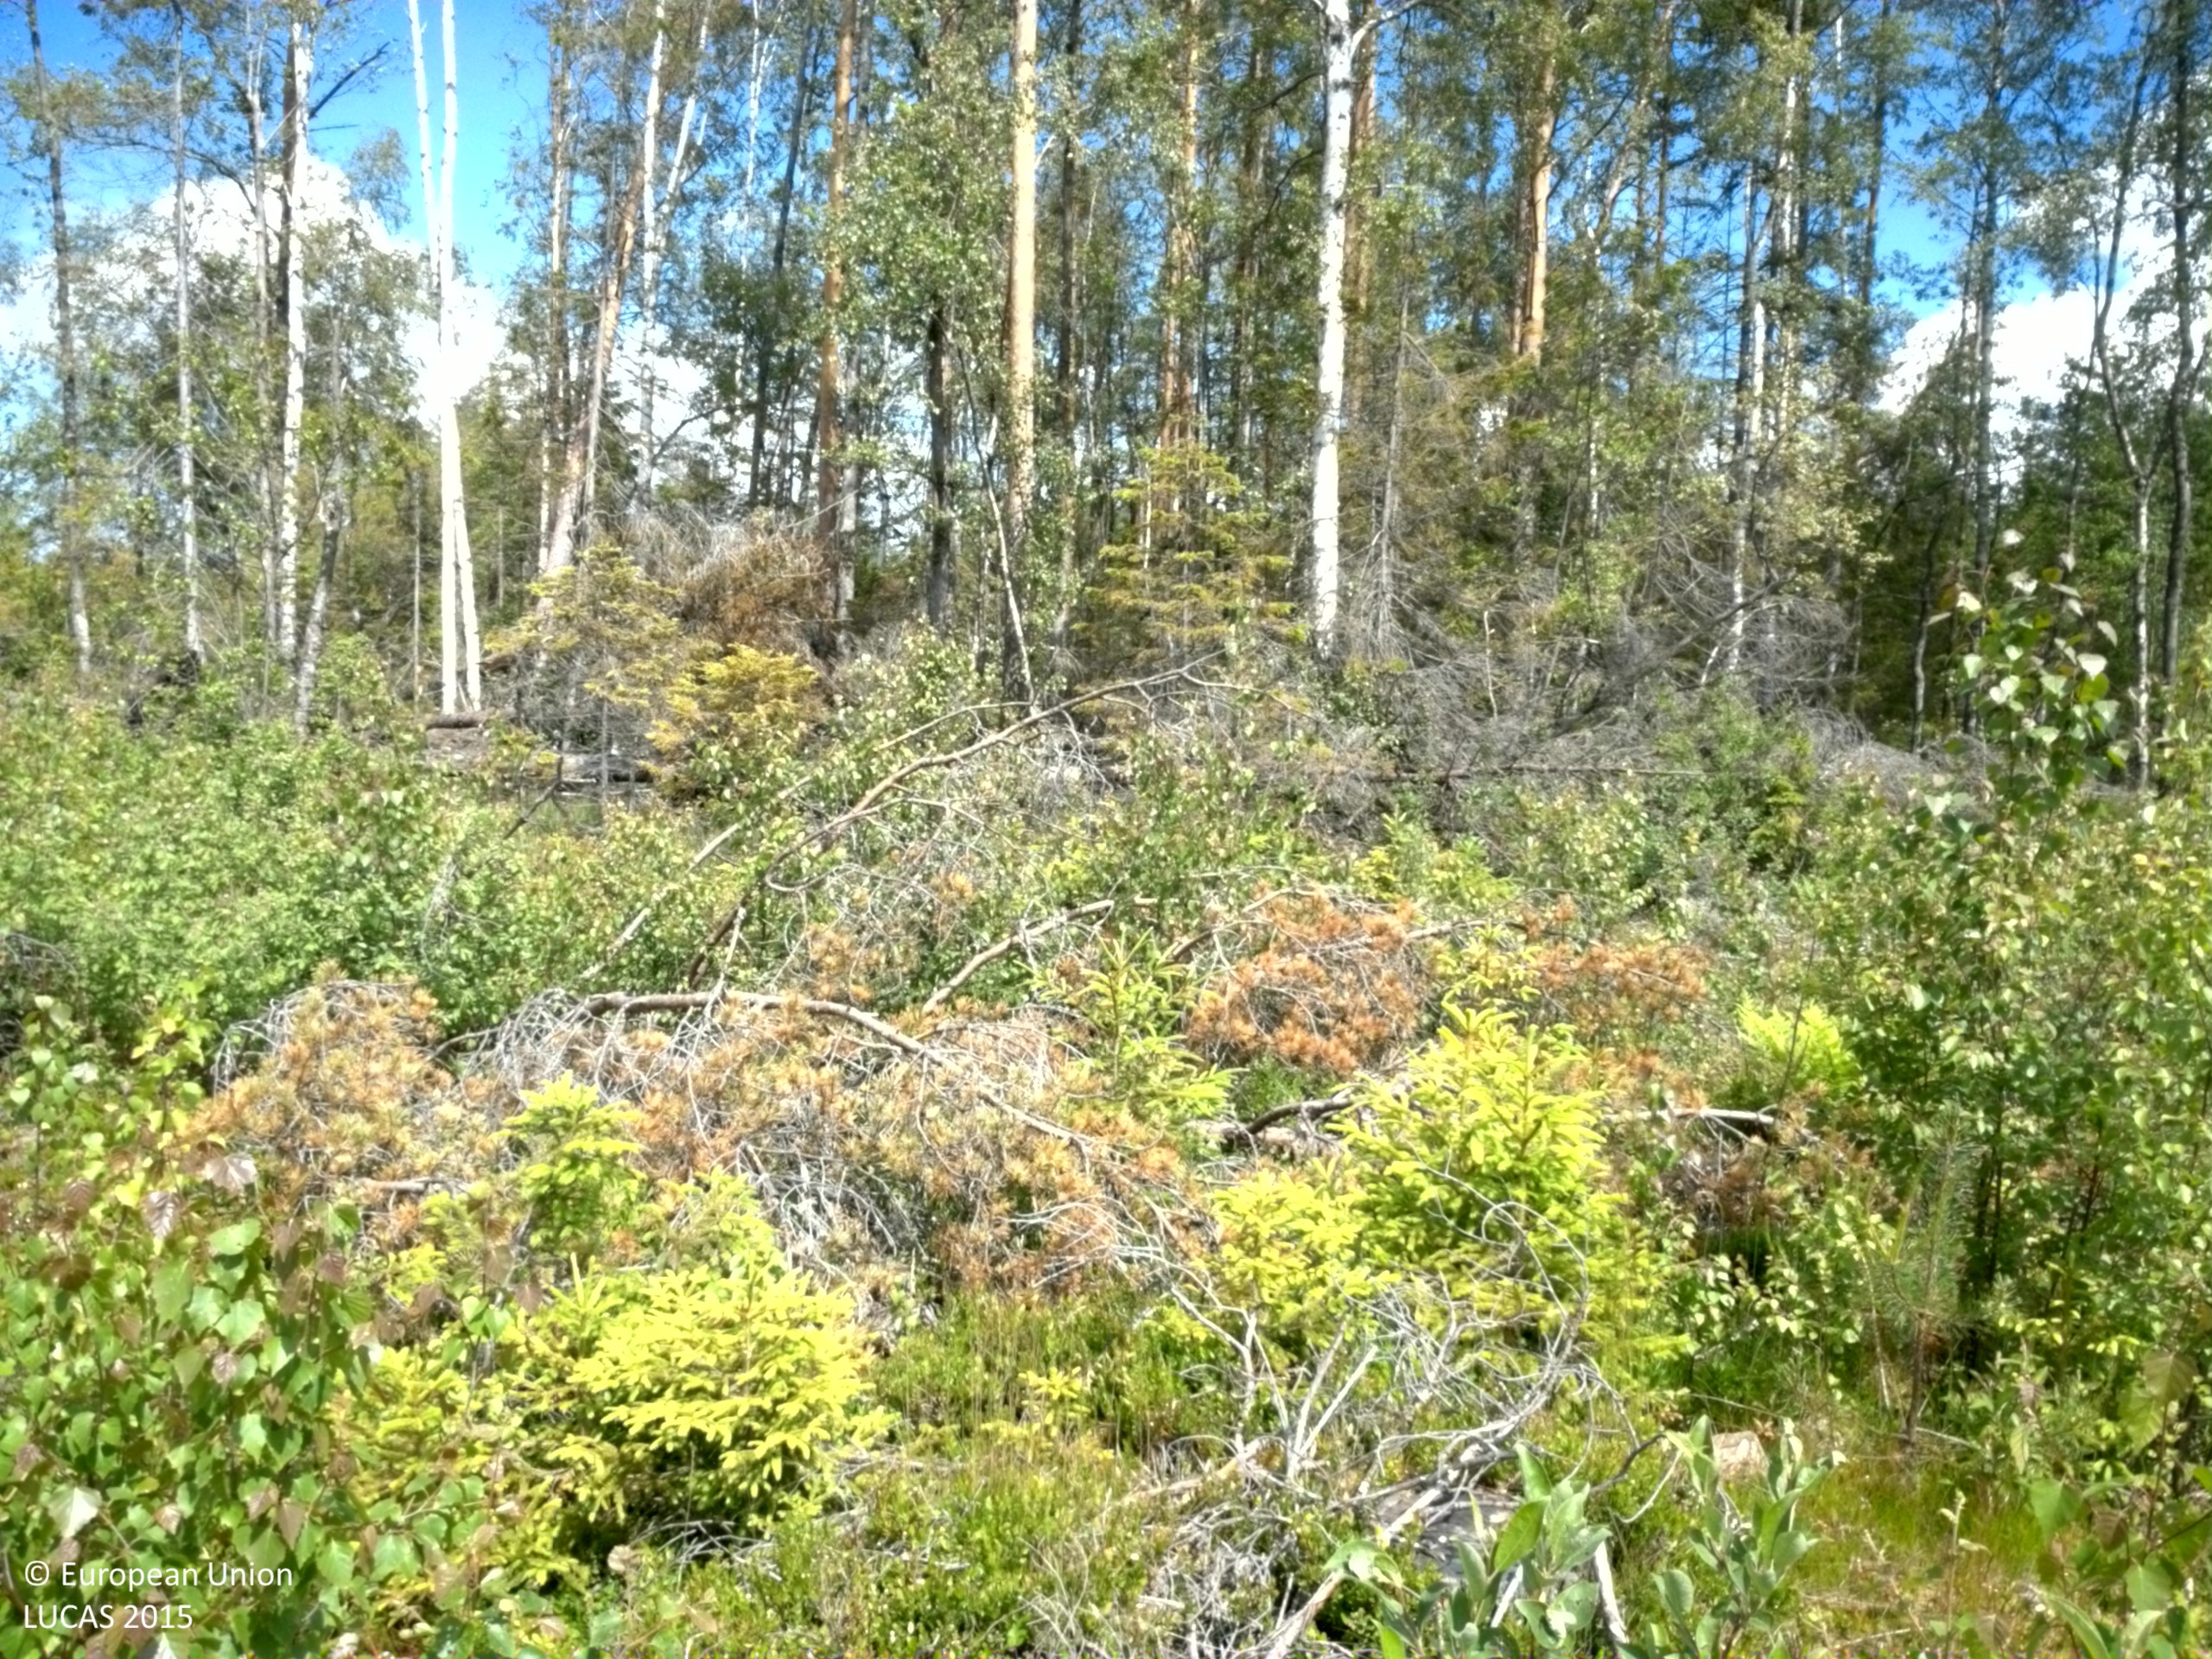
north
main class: Woodland
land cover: Broadleaved woodland
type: boreal forest
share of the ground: 25 - 50 %
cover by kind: herbaceous plants 45 %, broadleaved forest trees 35 %, lichens and mosses 10 %, coniferous forest trees 5 %, shrubs 5 %
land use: Forestry
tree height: < 5 m
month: June
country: SE
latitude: 60.4081
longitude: 17.6347
